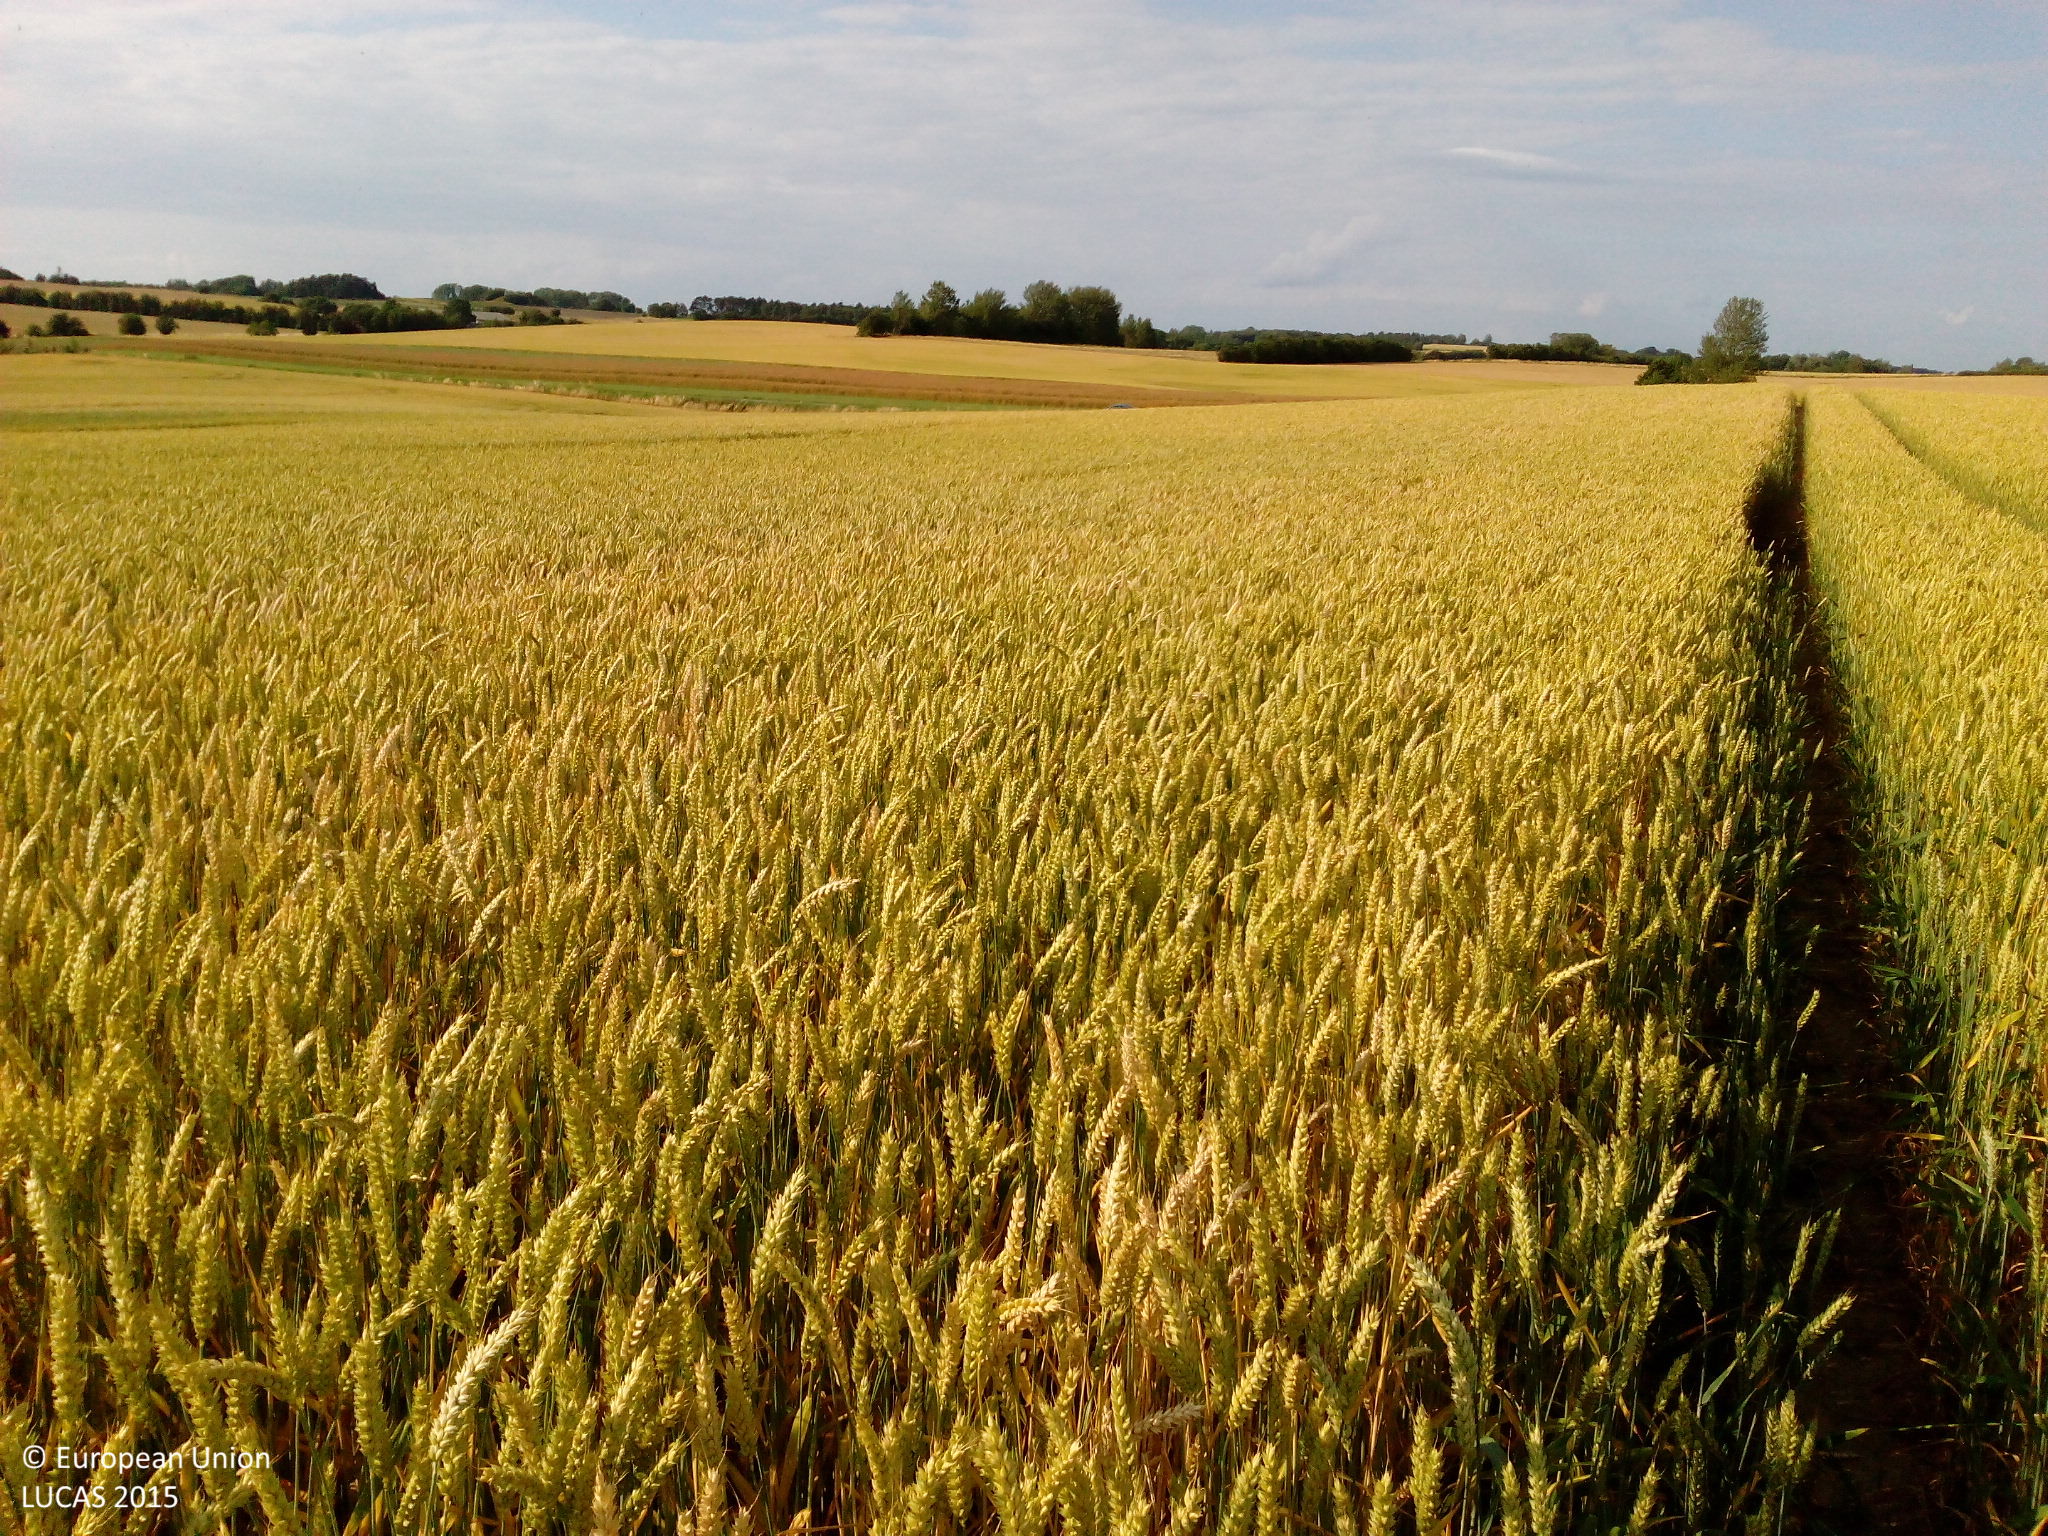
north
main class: Cropland
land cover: Common wheat
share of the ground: > 75 %
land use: Agriculture (excluding fallow land and kitchen gardens)
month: July
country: DK
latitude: 55.7423
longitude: 11.8938
